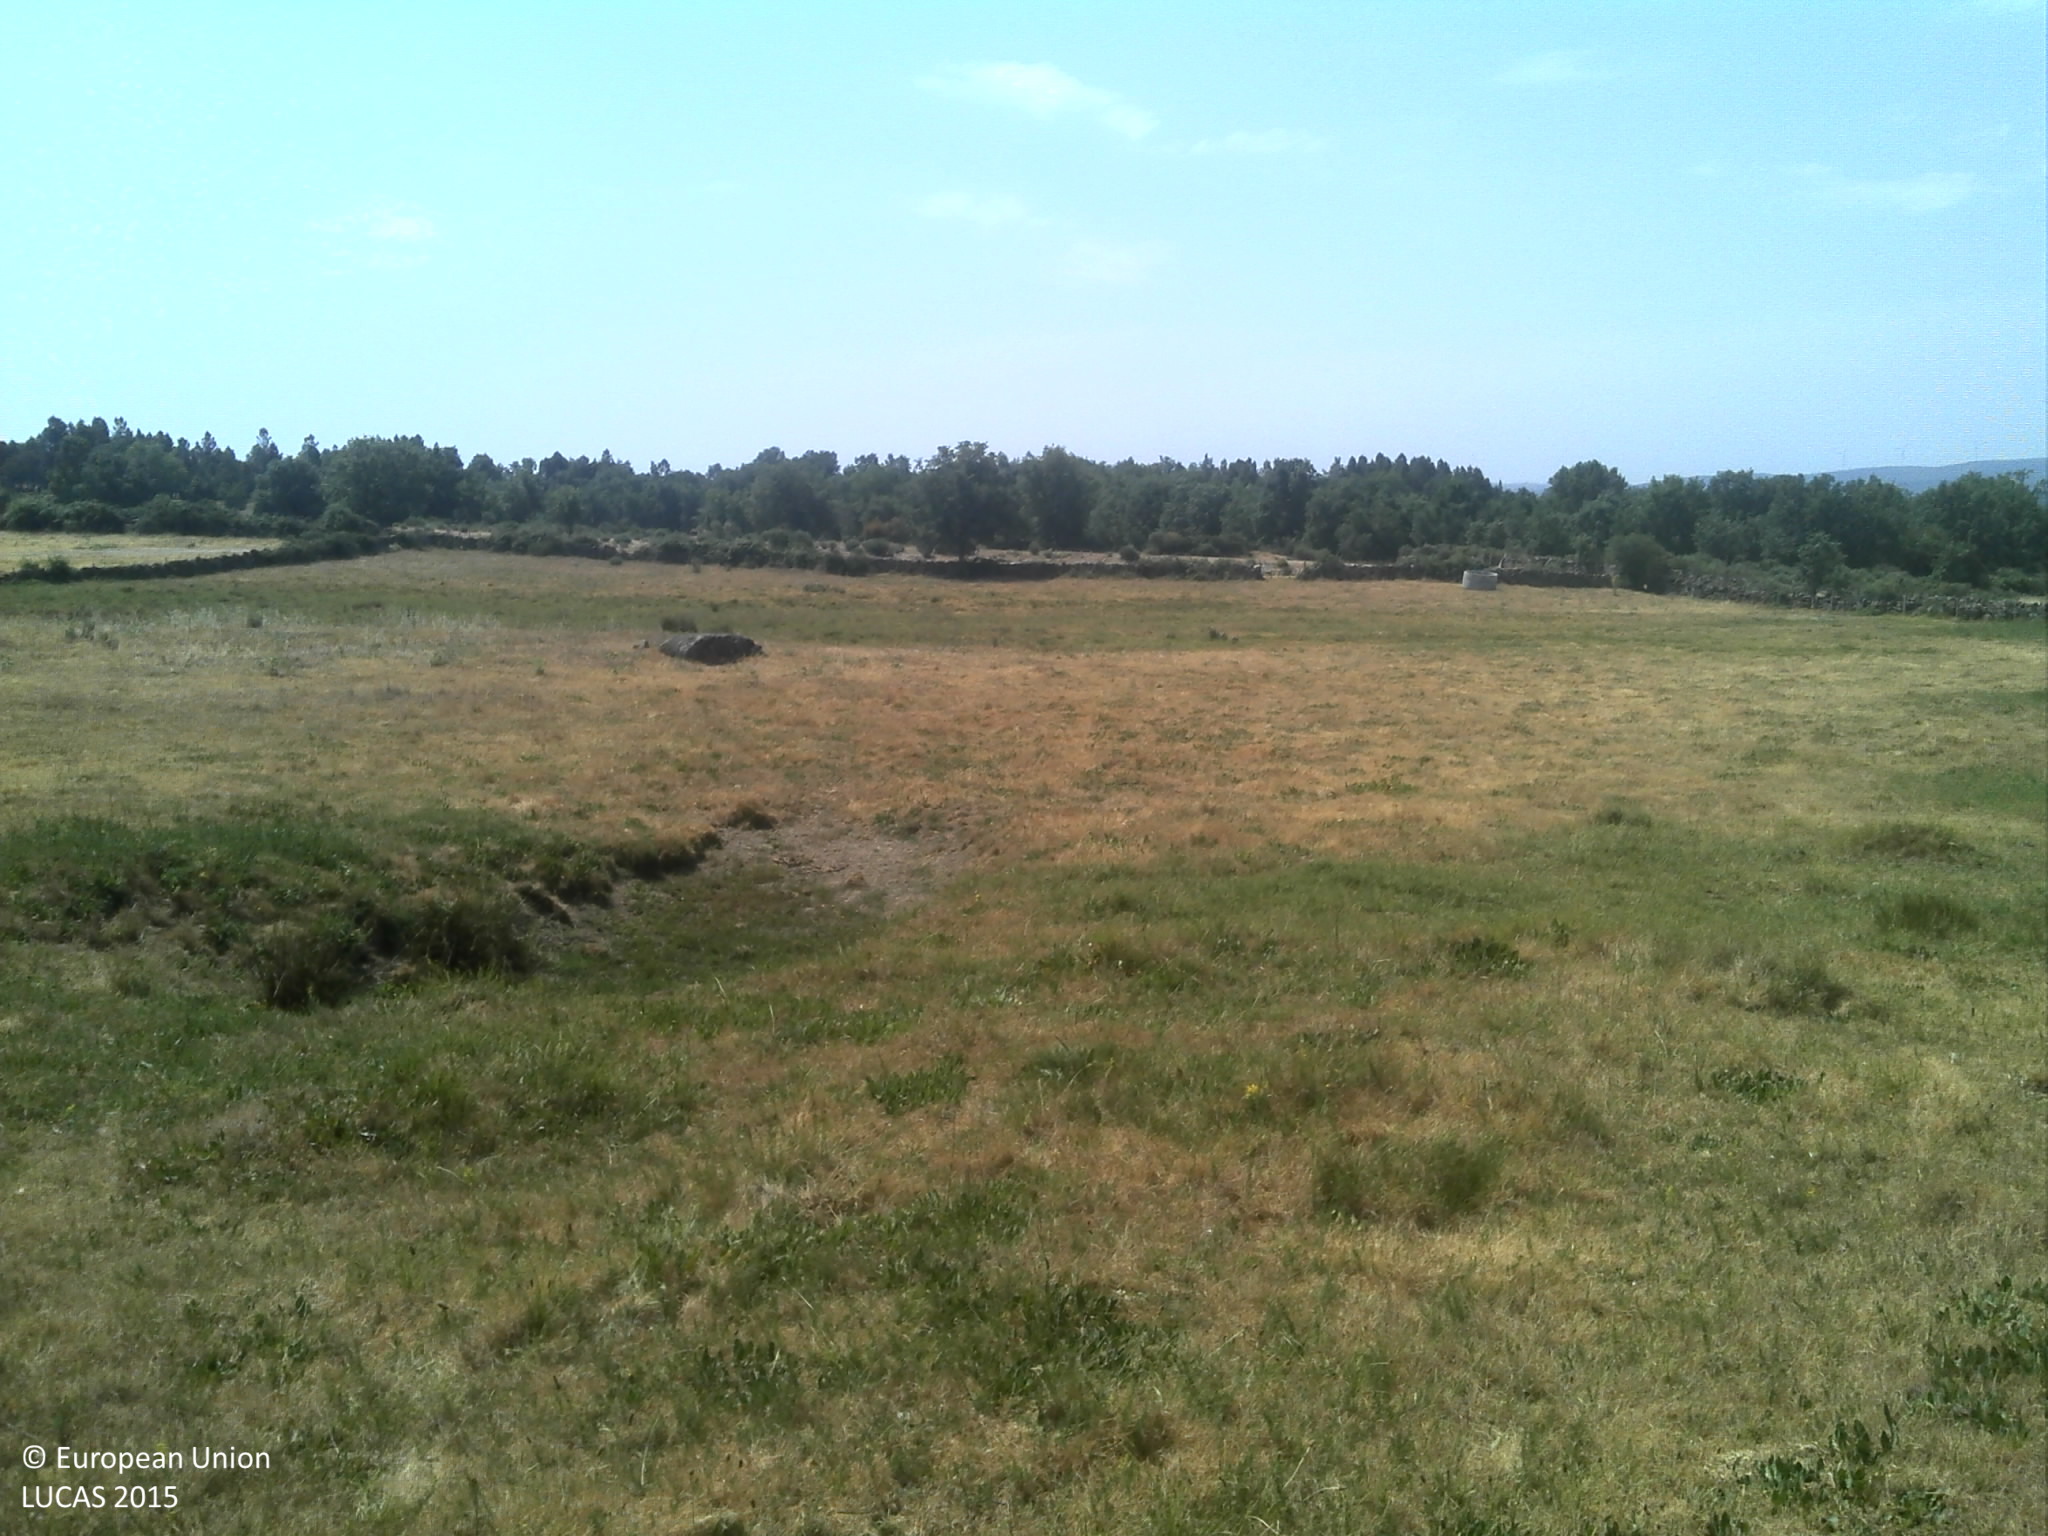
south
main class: Grassland
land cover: Grassland without tree/shrub cover
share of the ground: 50 - 75 %
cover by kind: herbaceous plants 70 %, unconsolidated bare surface 20 %
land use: Agriculture (excluding fallow land and kitchen gardens)
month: June
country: PT
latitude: 40.3998
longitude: -6.8601
